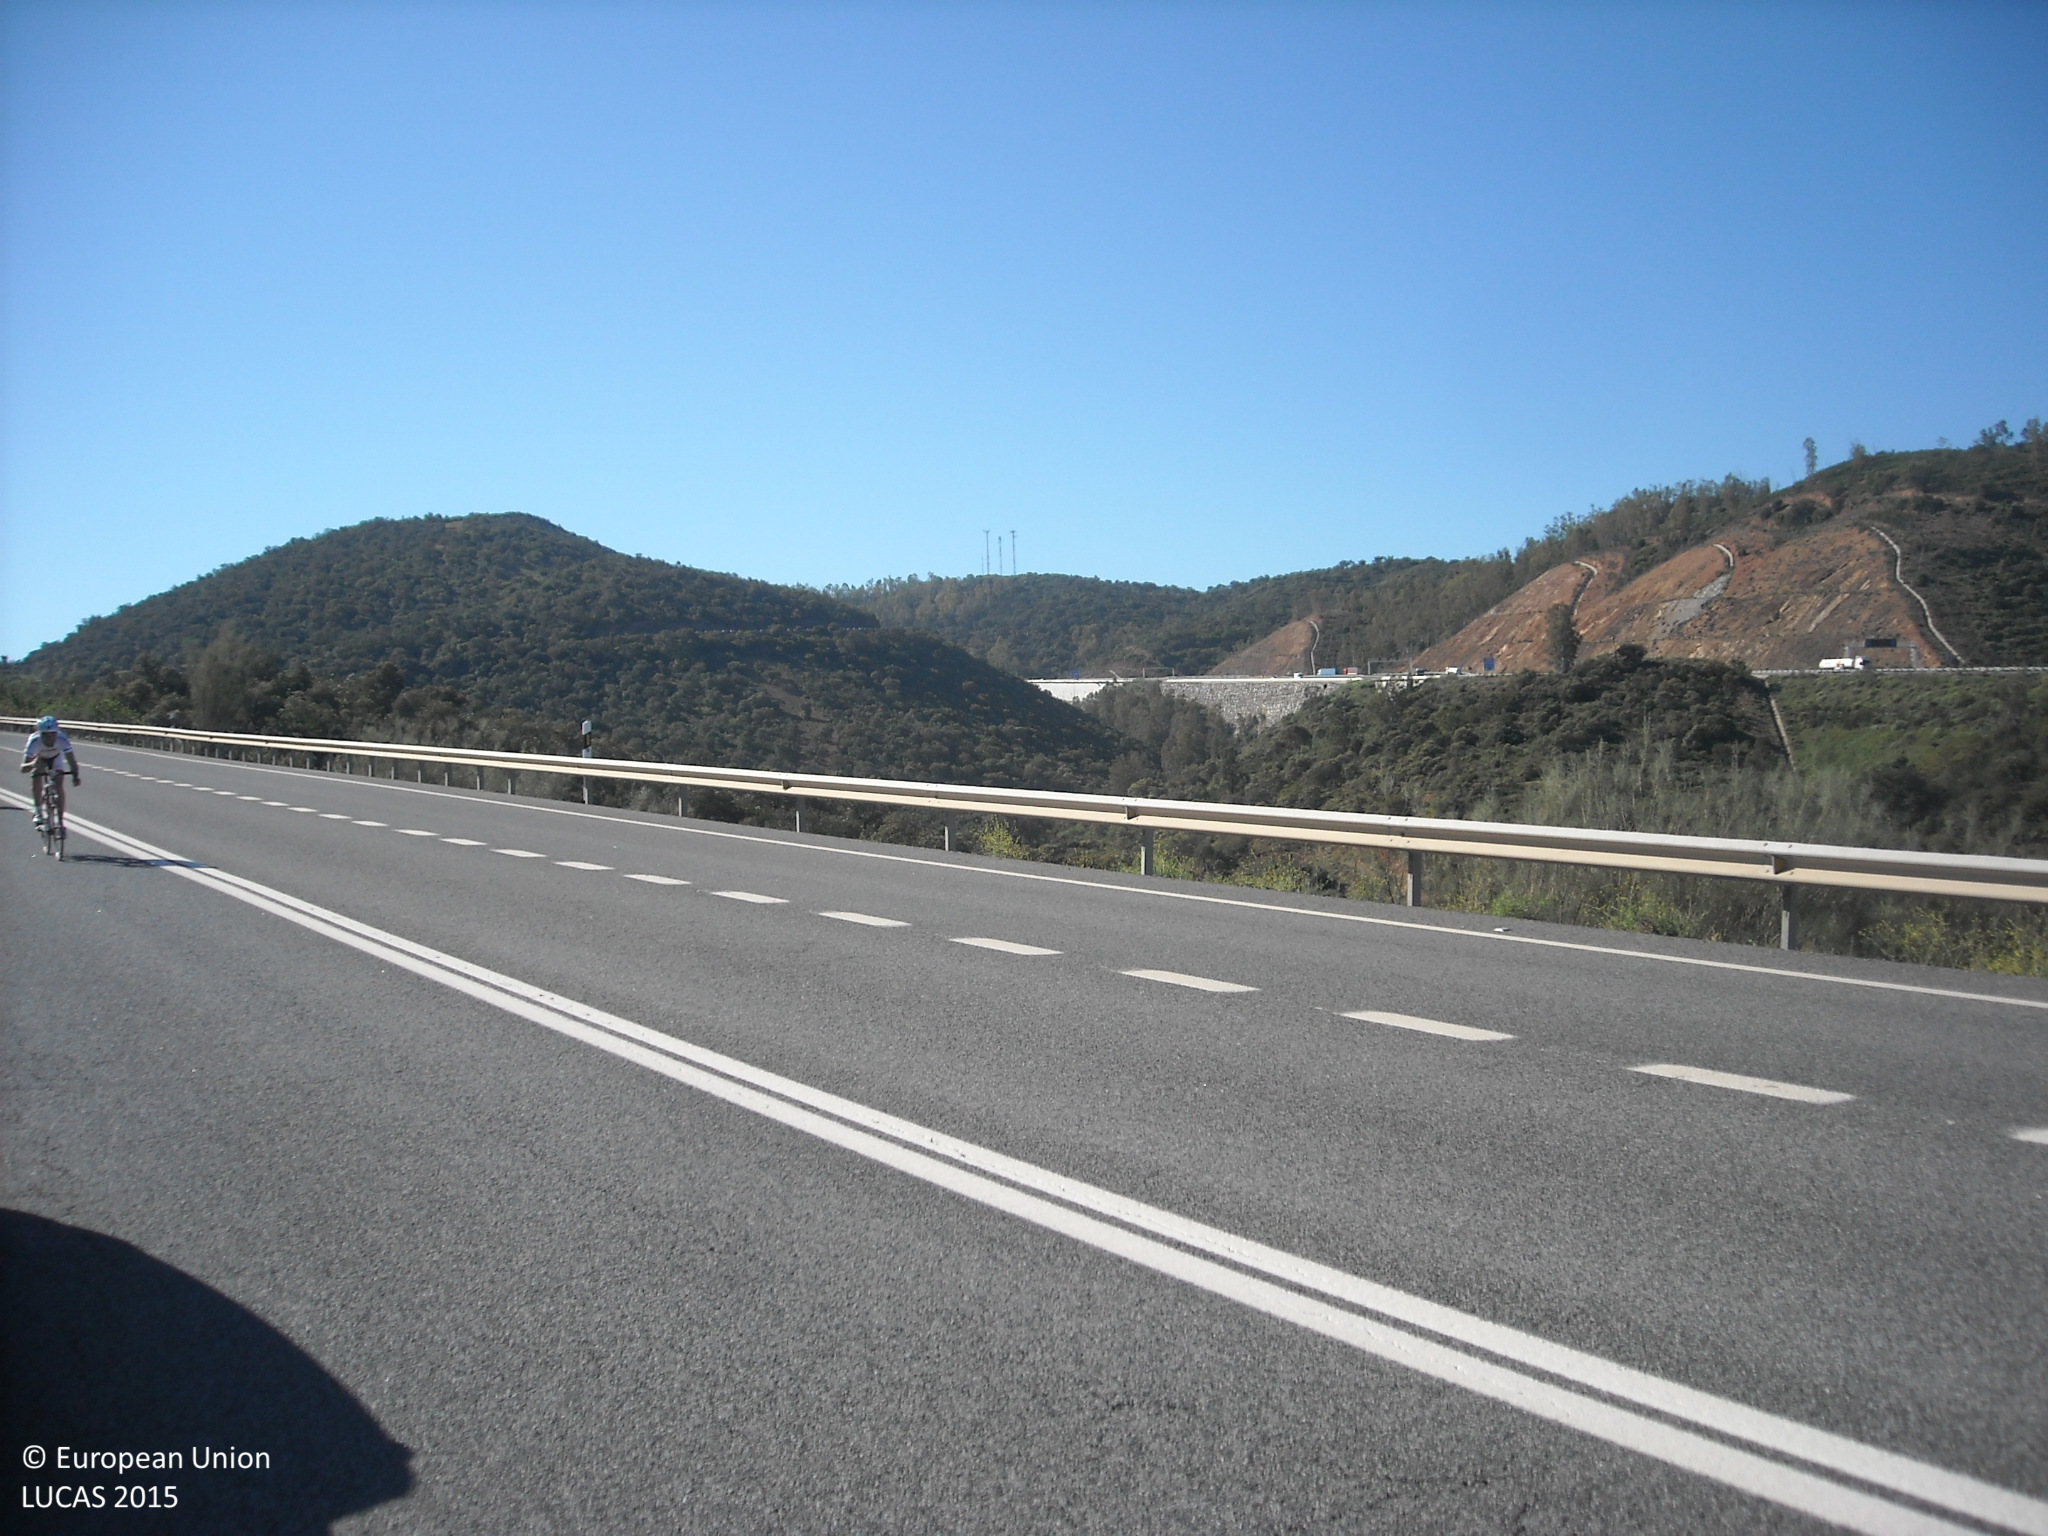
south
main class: Woodland
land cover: Broadleaved woodland
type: broadleaved evergreen forest
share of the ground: 10 - 25 %
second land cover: Grassland without tree/shrub cover
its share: > 75 %
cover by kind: herbaceous plants 75 %, broadleaved forest trees 25 %
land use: Forestry
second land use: Agriculture (excluding fallow land and kitchen gardens)
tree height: > 5 m
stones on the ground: < 10 %
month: April
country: ES
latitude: 37.6643
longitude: -6.1635
